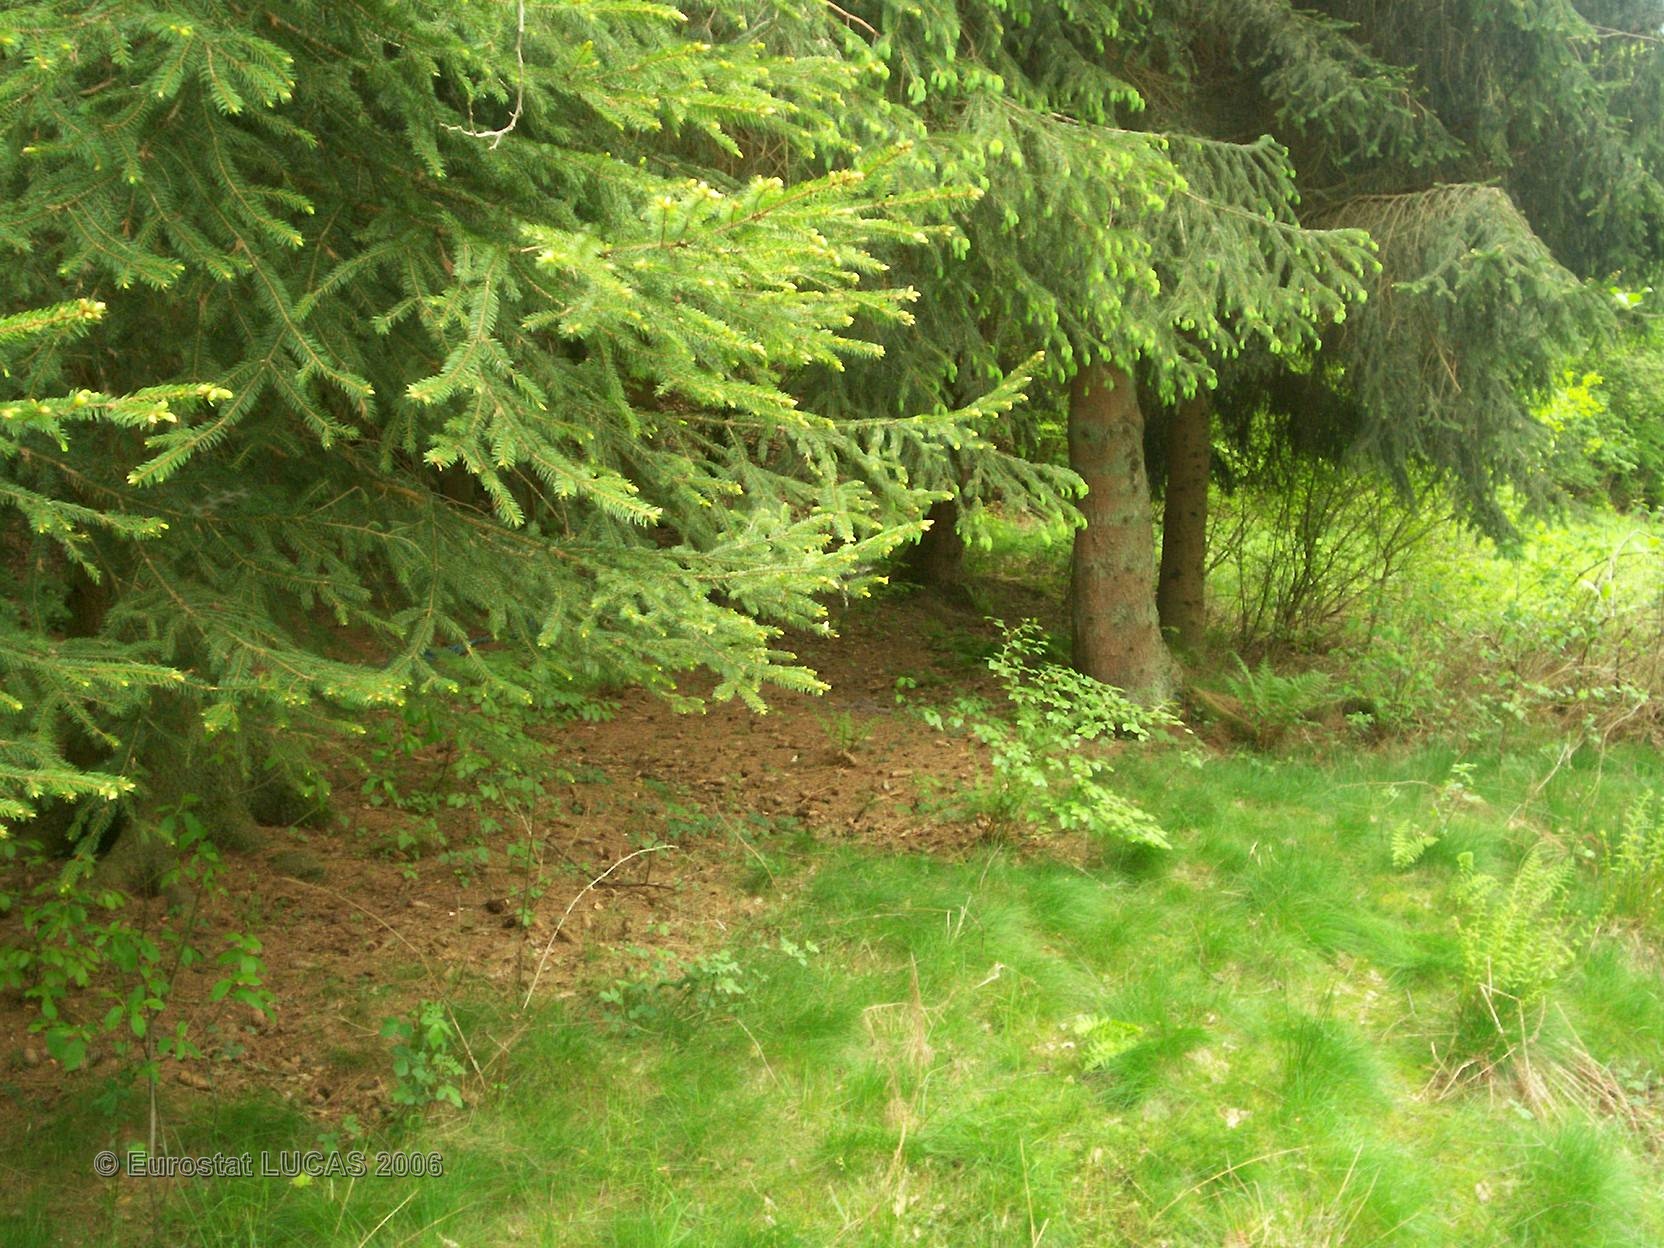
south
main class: Grassland
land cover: Grassland with sparse tree/shrub cover
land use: Unused
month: May
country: FR
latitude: 48.9122
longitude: 7.3672
